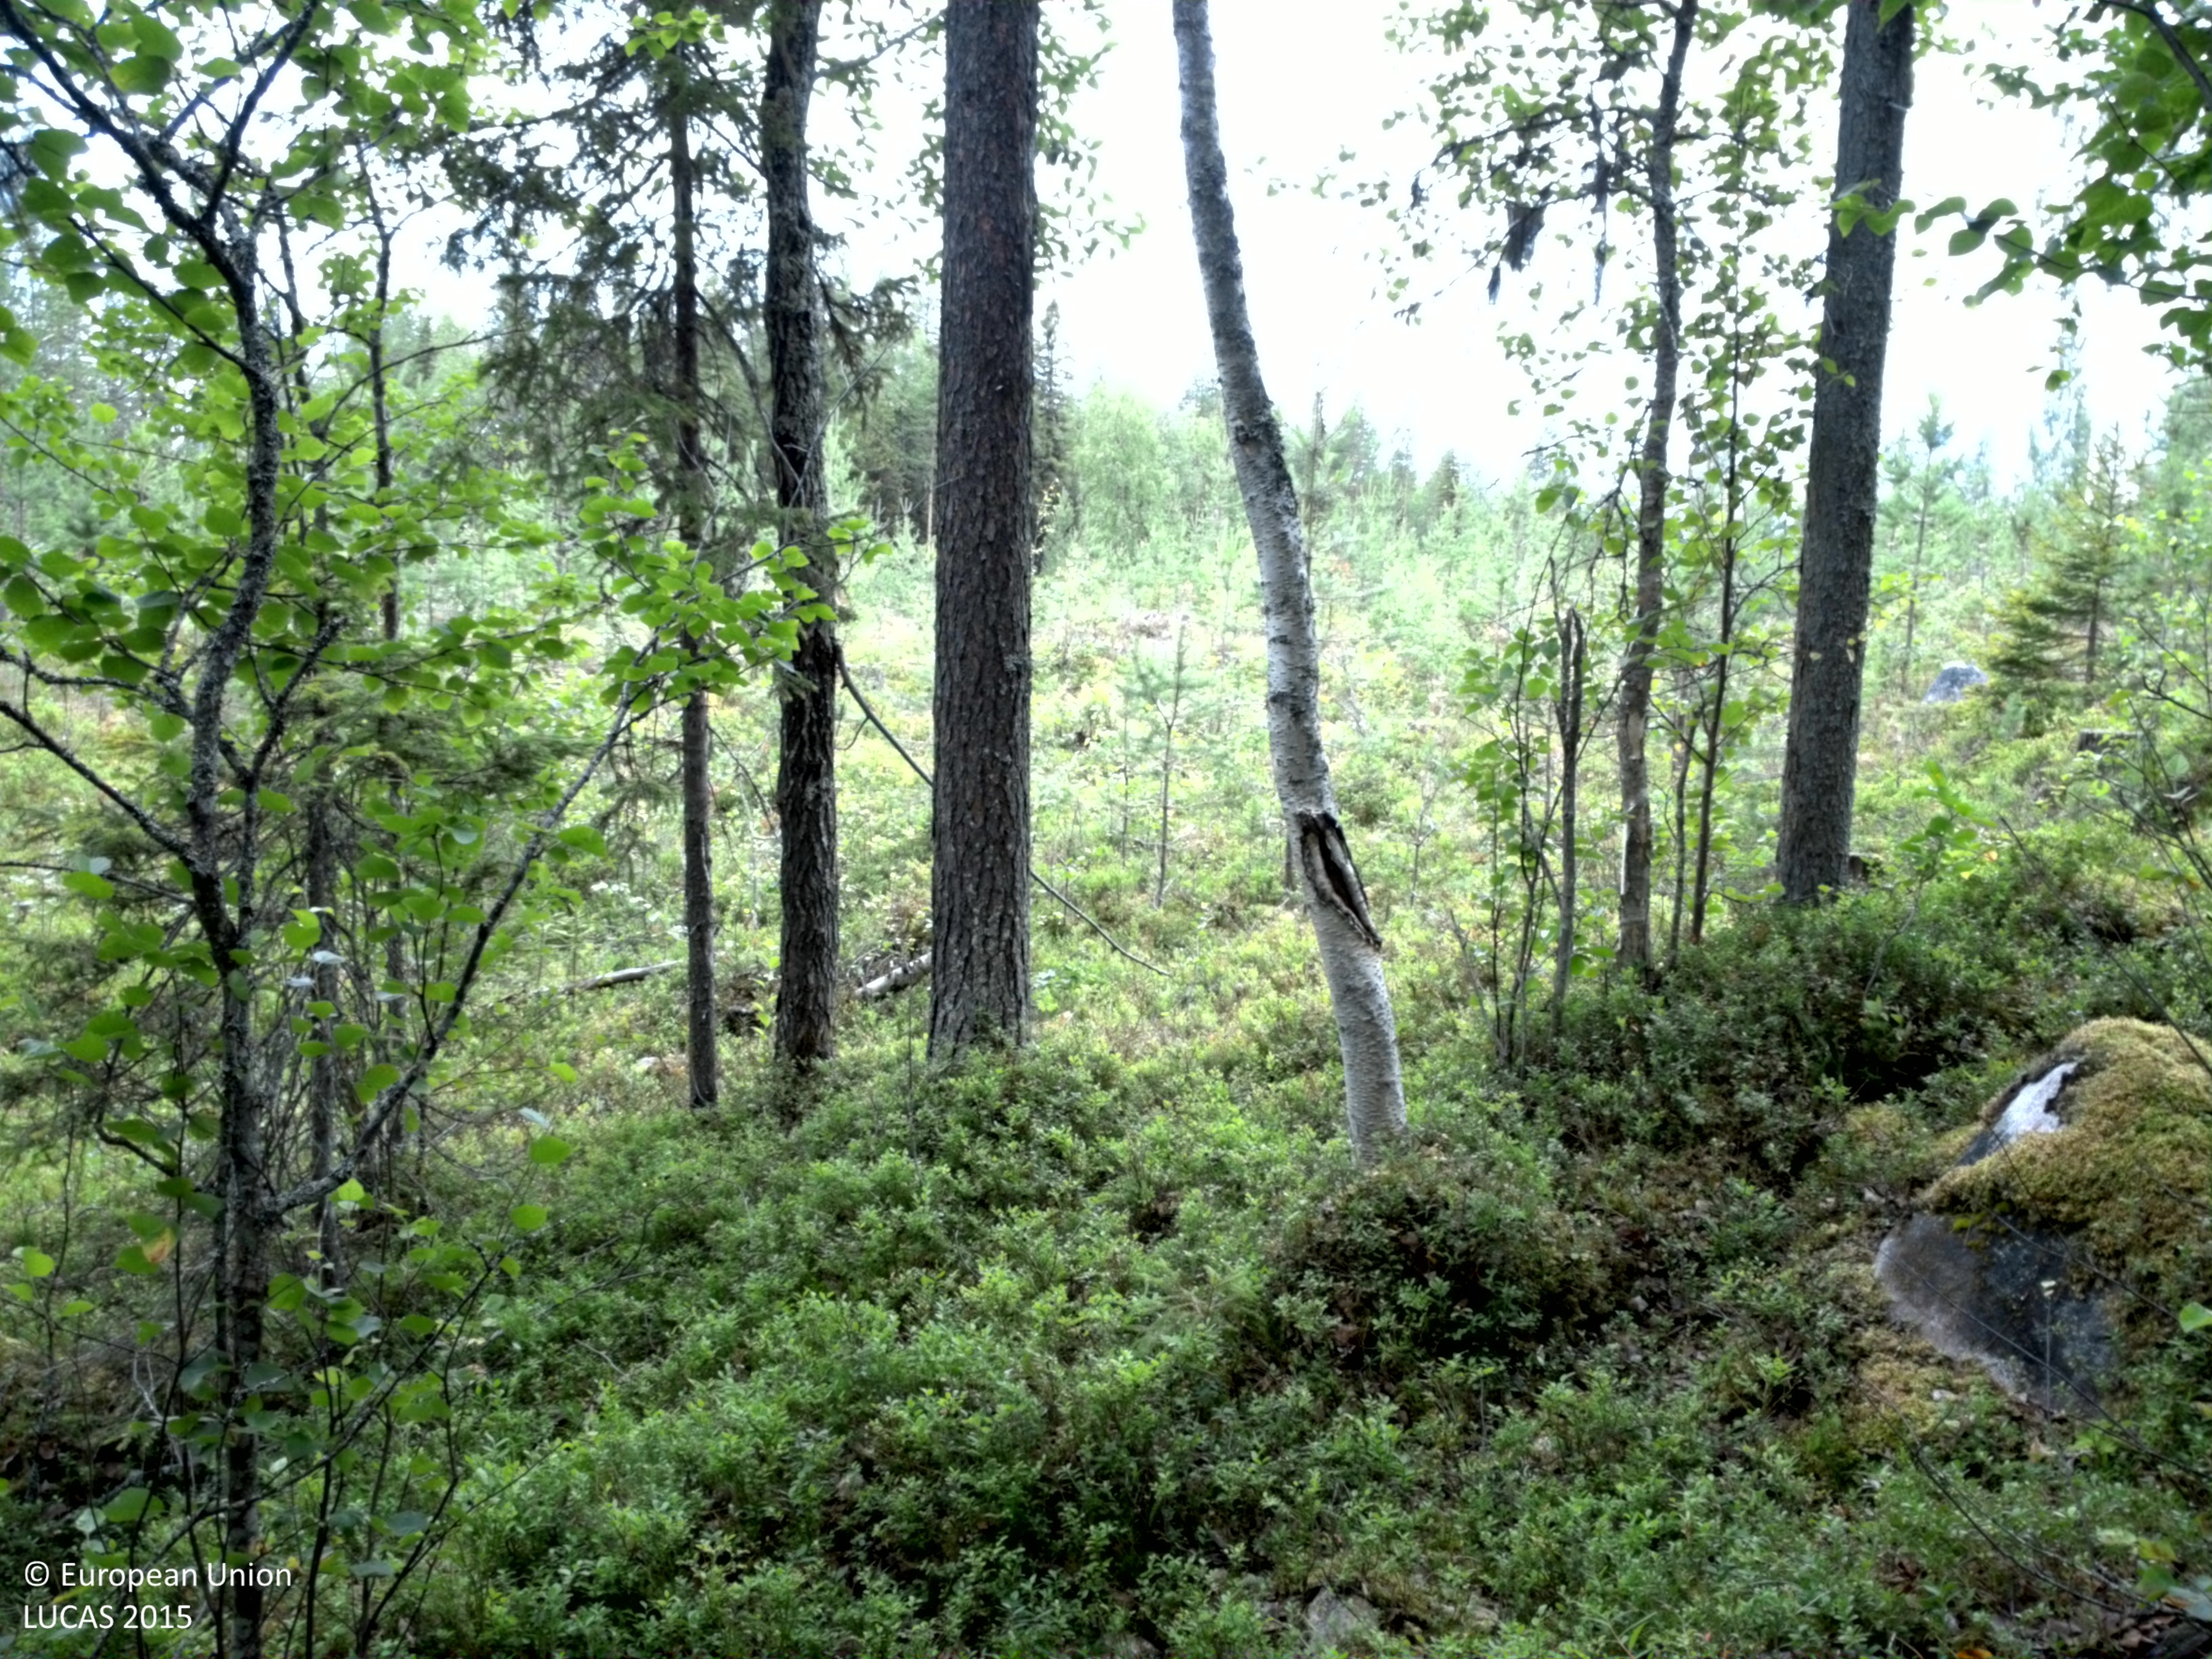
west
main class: Woodland
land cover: Spruce dominated mixed woodland
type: boreal forest
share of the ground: 50 - 75 %
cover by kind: shrubs 40 %, coniferous forest trees 35 %, broadleaved forest trees 25 %
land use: Forestry
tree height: > 5 m
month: August
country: SE
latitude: 66.2986
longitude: 20.4588
